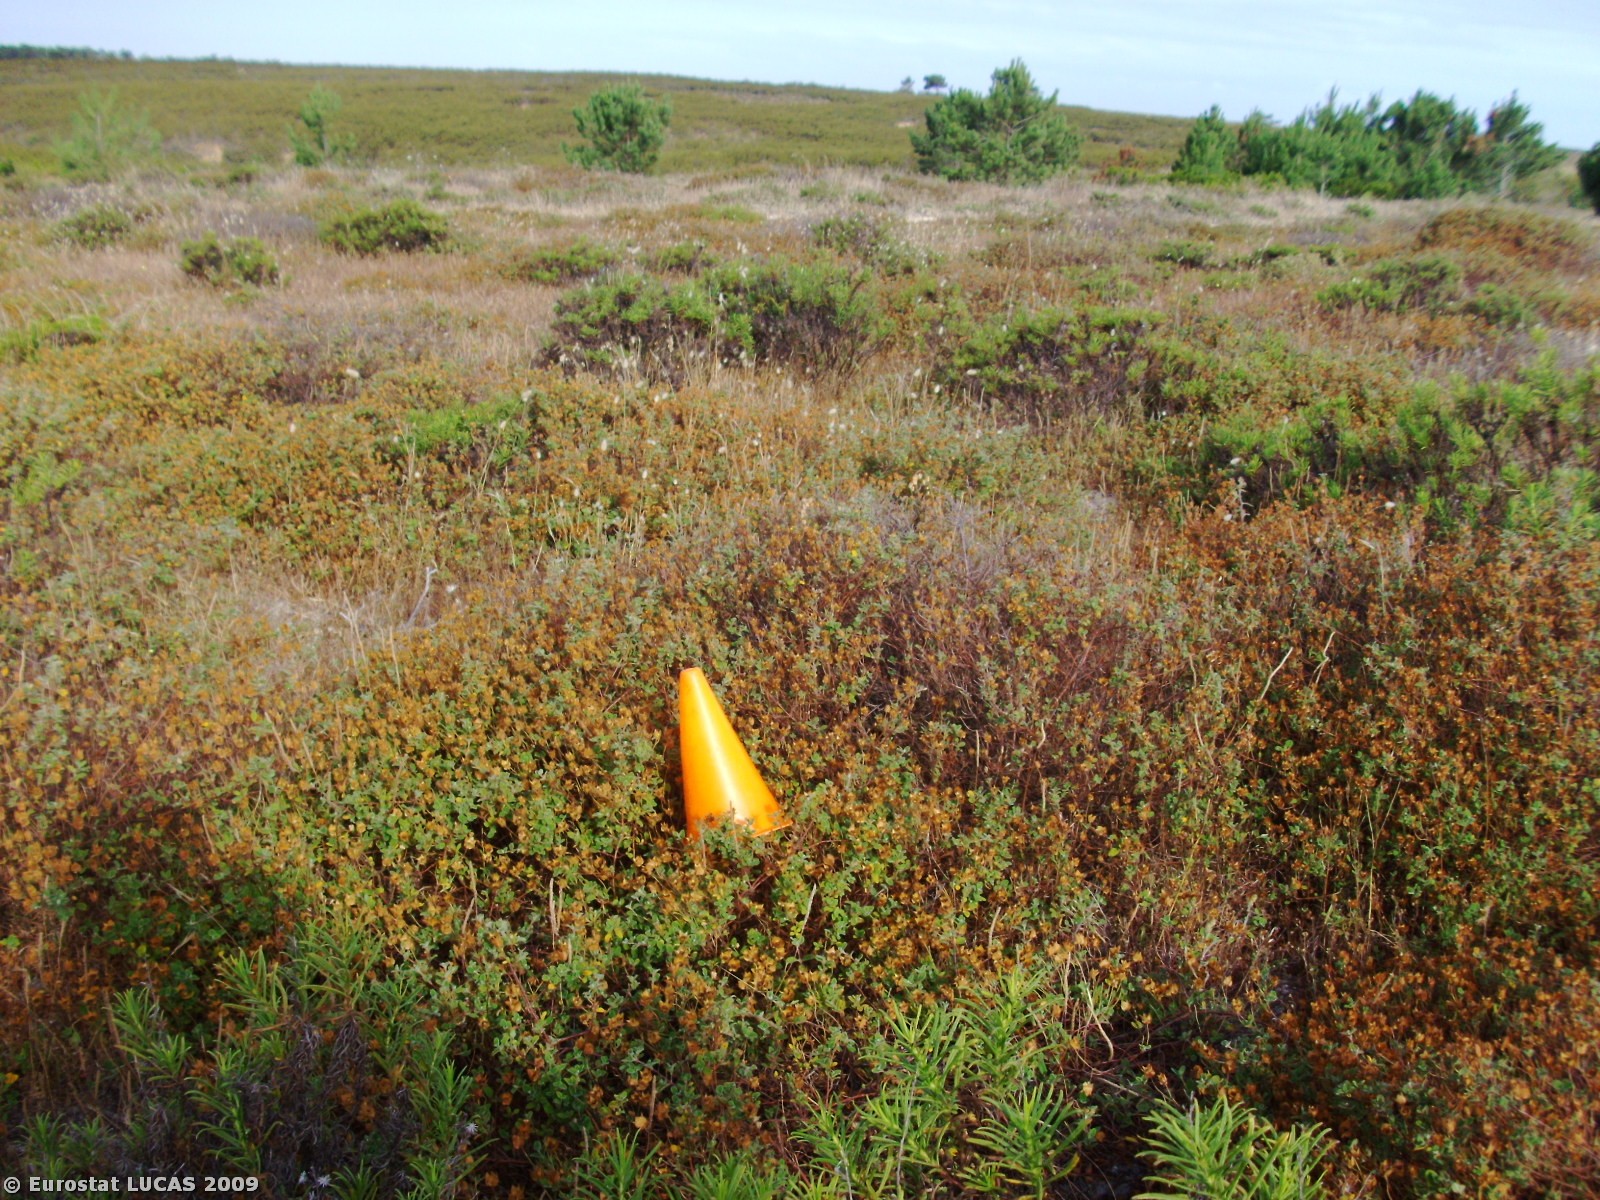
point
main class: Shrubland
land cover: Shrubland without tree cover
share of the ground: > 75 %
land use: Nature reserves
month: June
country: PT
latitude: 37.1125
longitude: -8.9065
